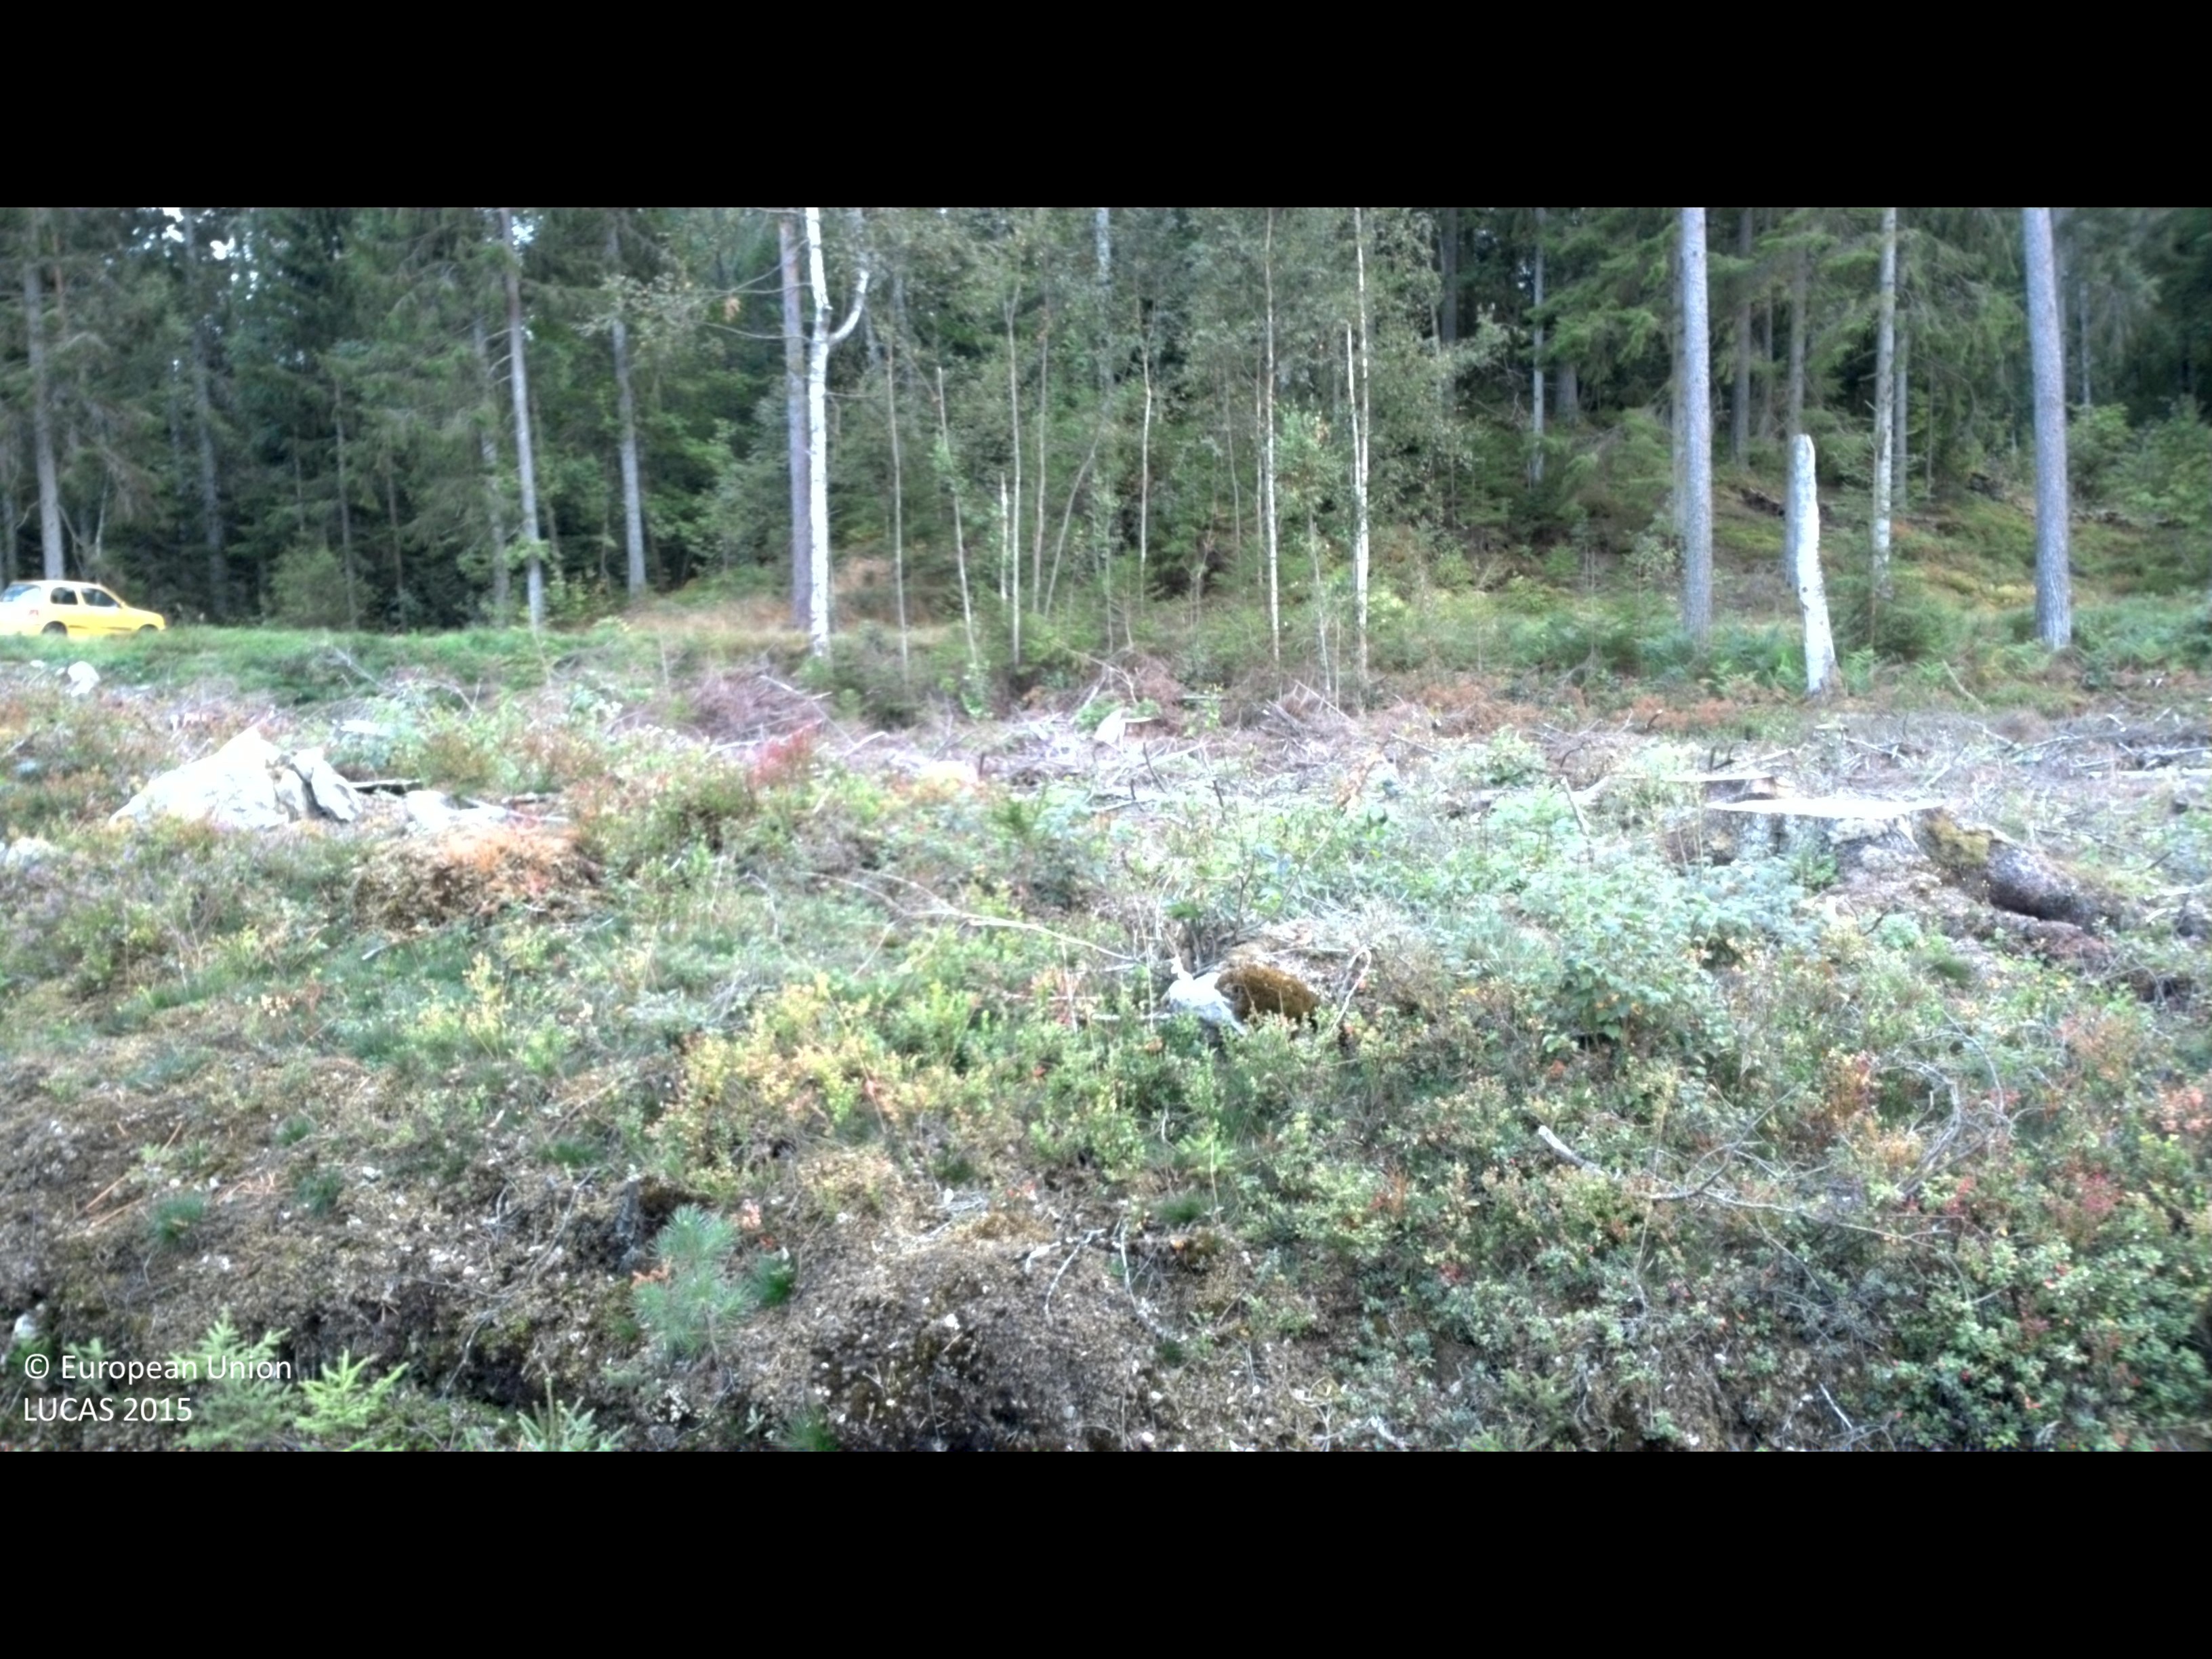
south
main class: Shrubland
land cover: Shrubland with sparse tree cover
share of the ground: > 75 %
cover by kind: shrubs 90 %, coniferous forest trees 5 %
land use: Forestry
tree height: < 5 m
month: August
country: SE
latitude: 56.3639
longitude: 14.4168
